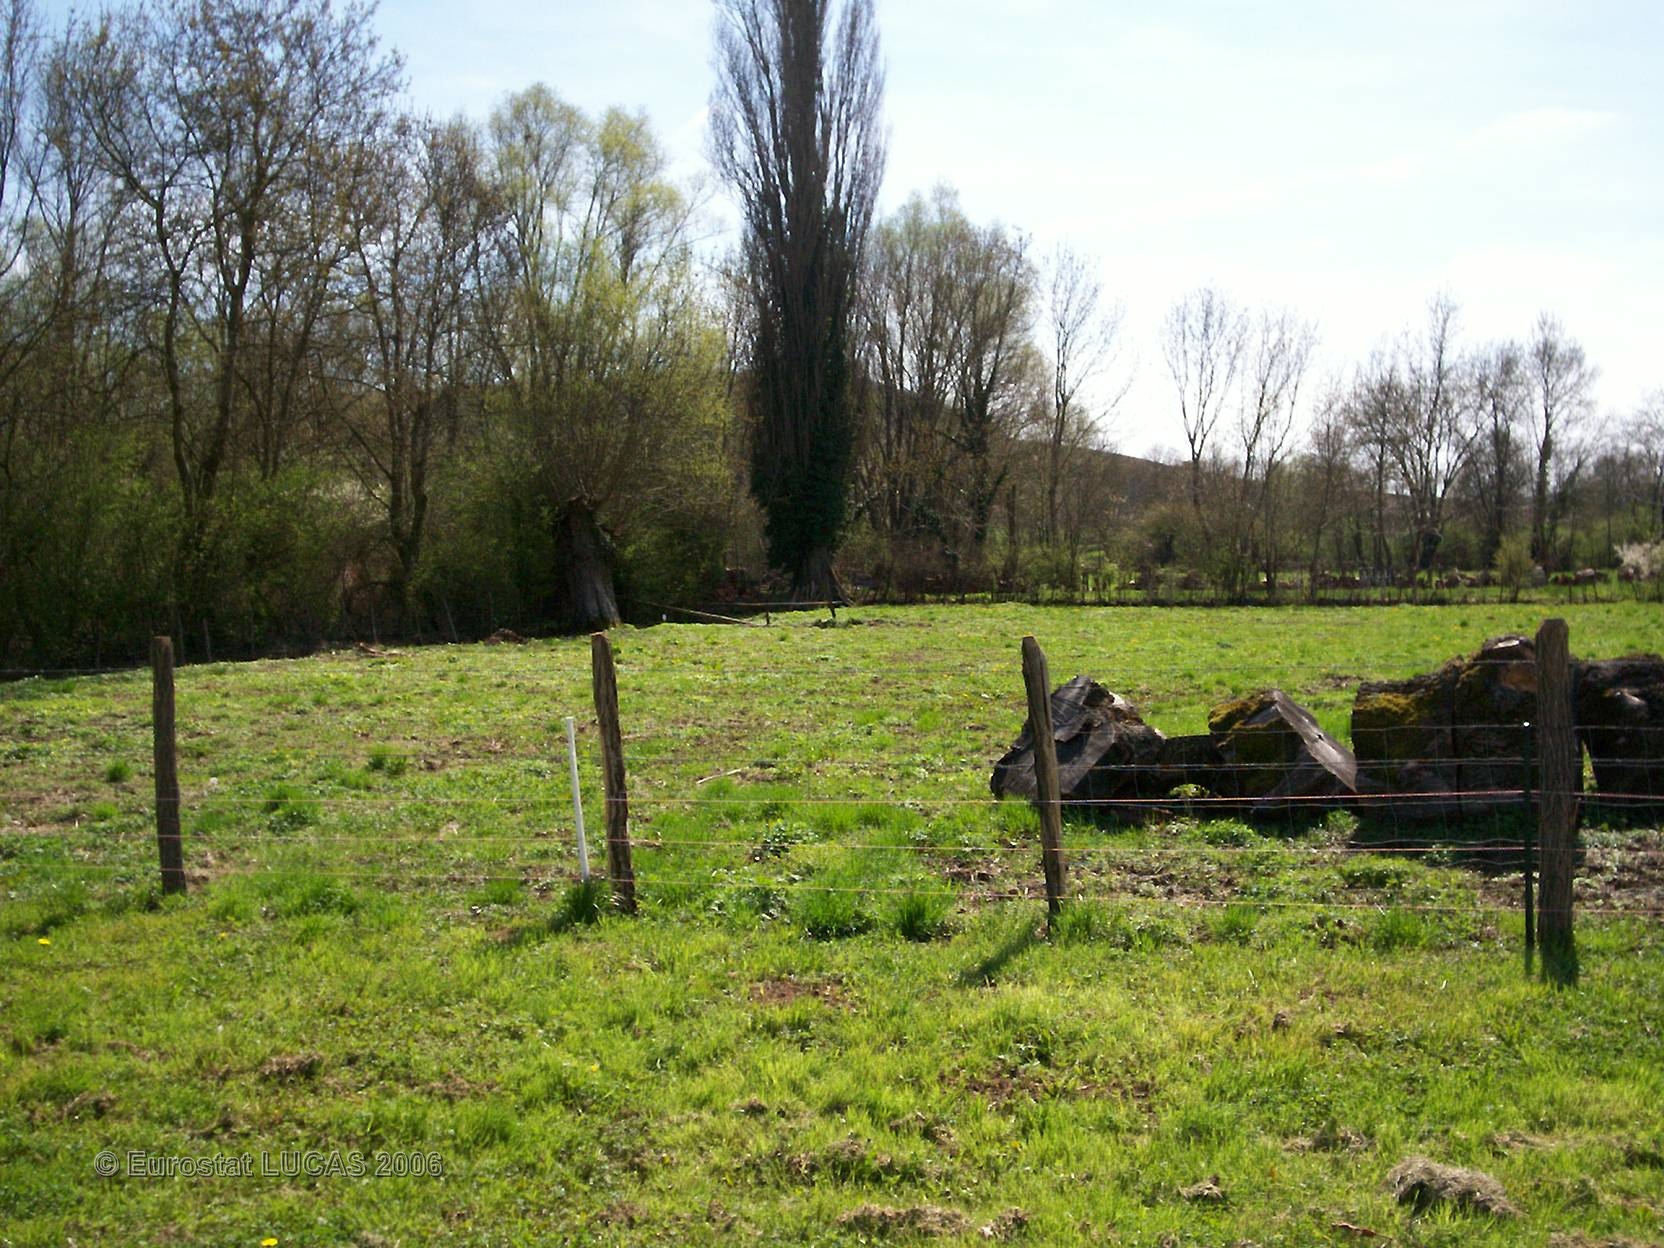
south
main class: Grassland
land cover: Grassland without tree/shrub cover
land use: Residential
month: April
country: FR
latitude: 46.4212
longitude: 4.7583
